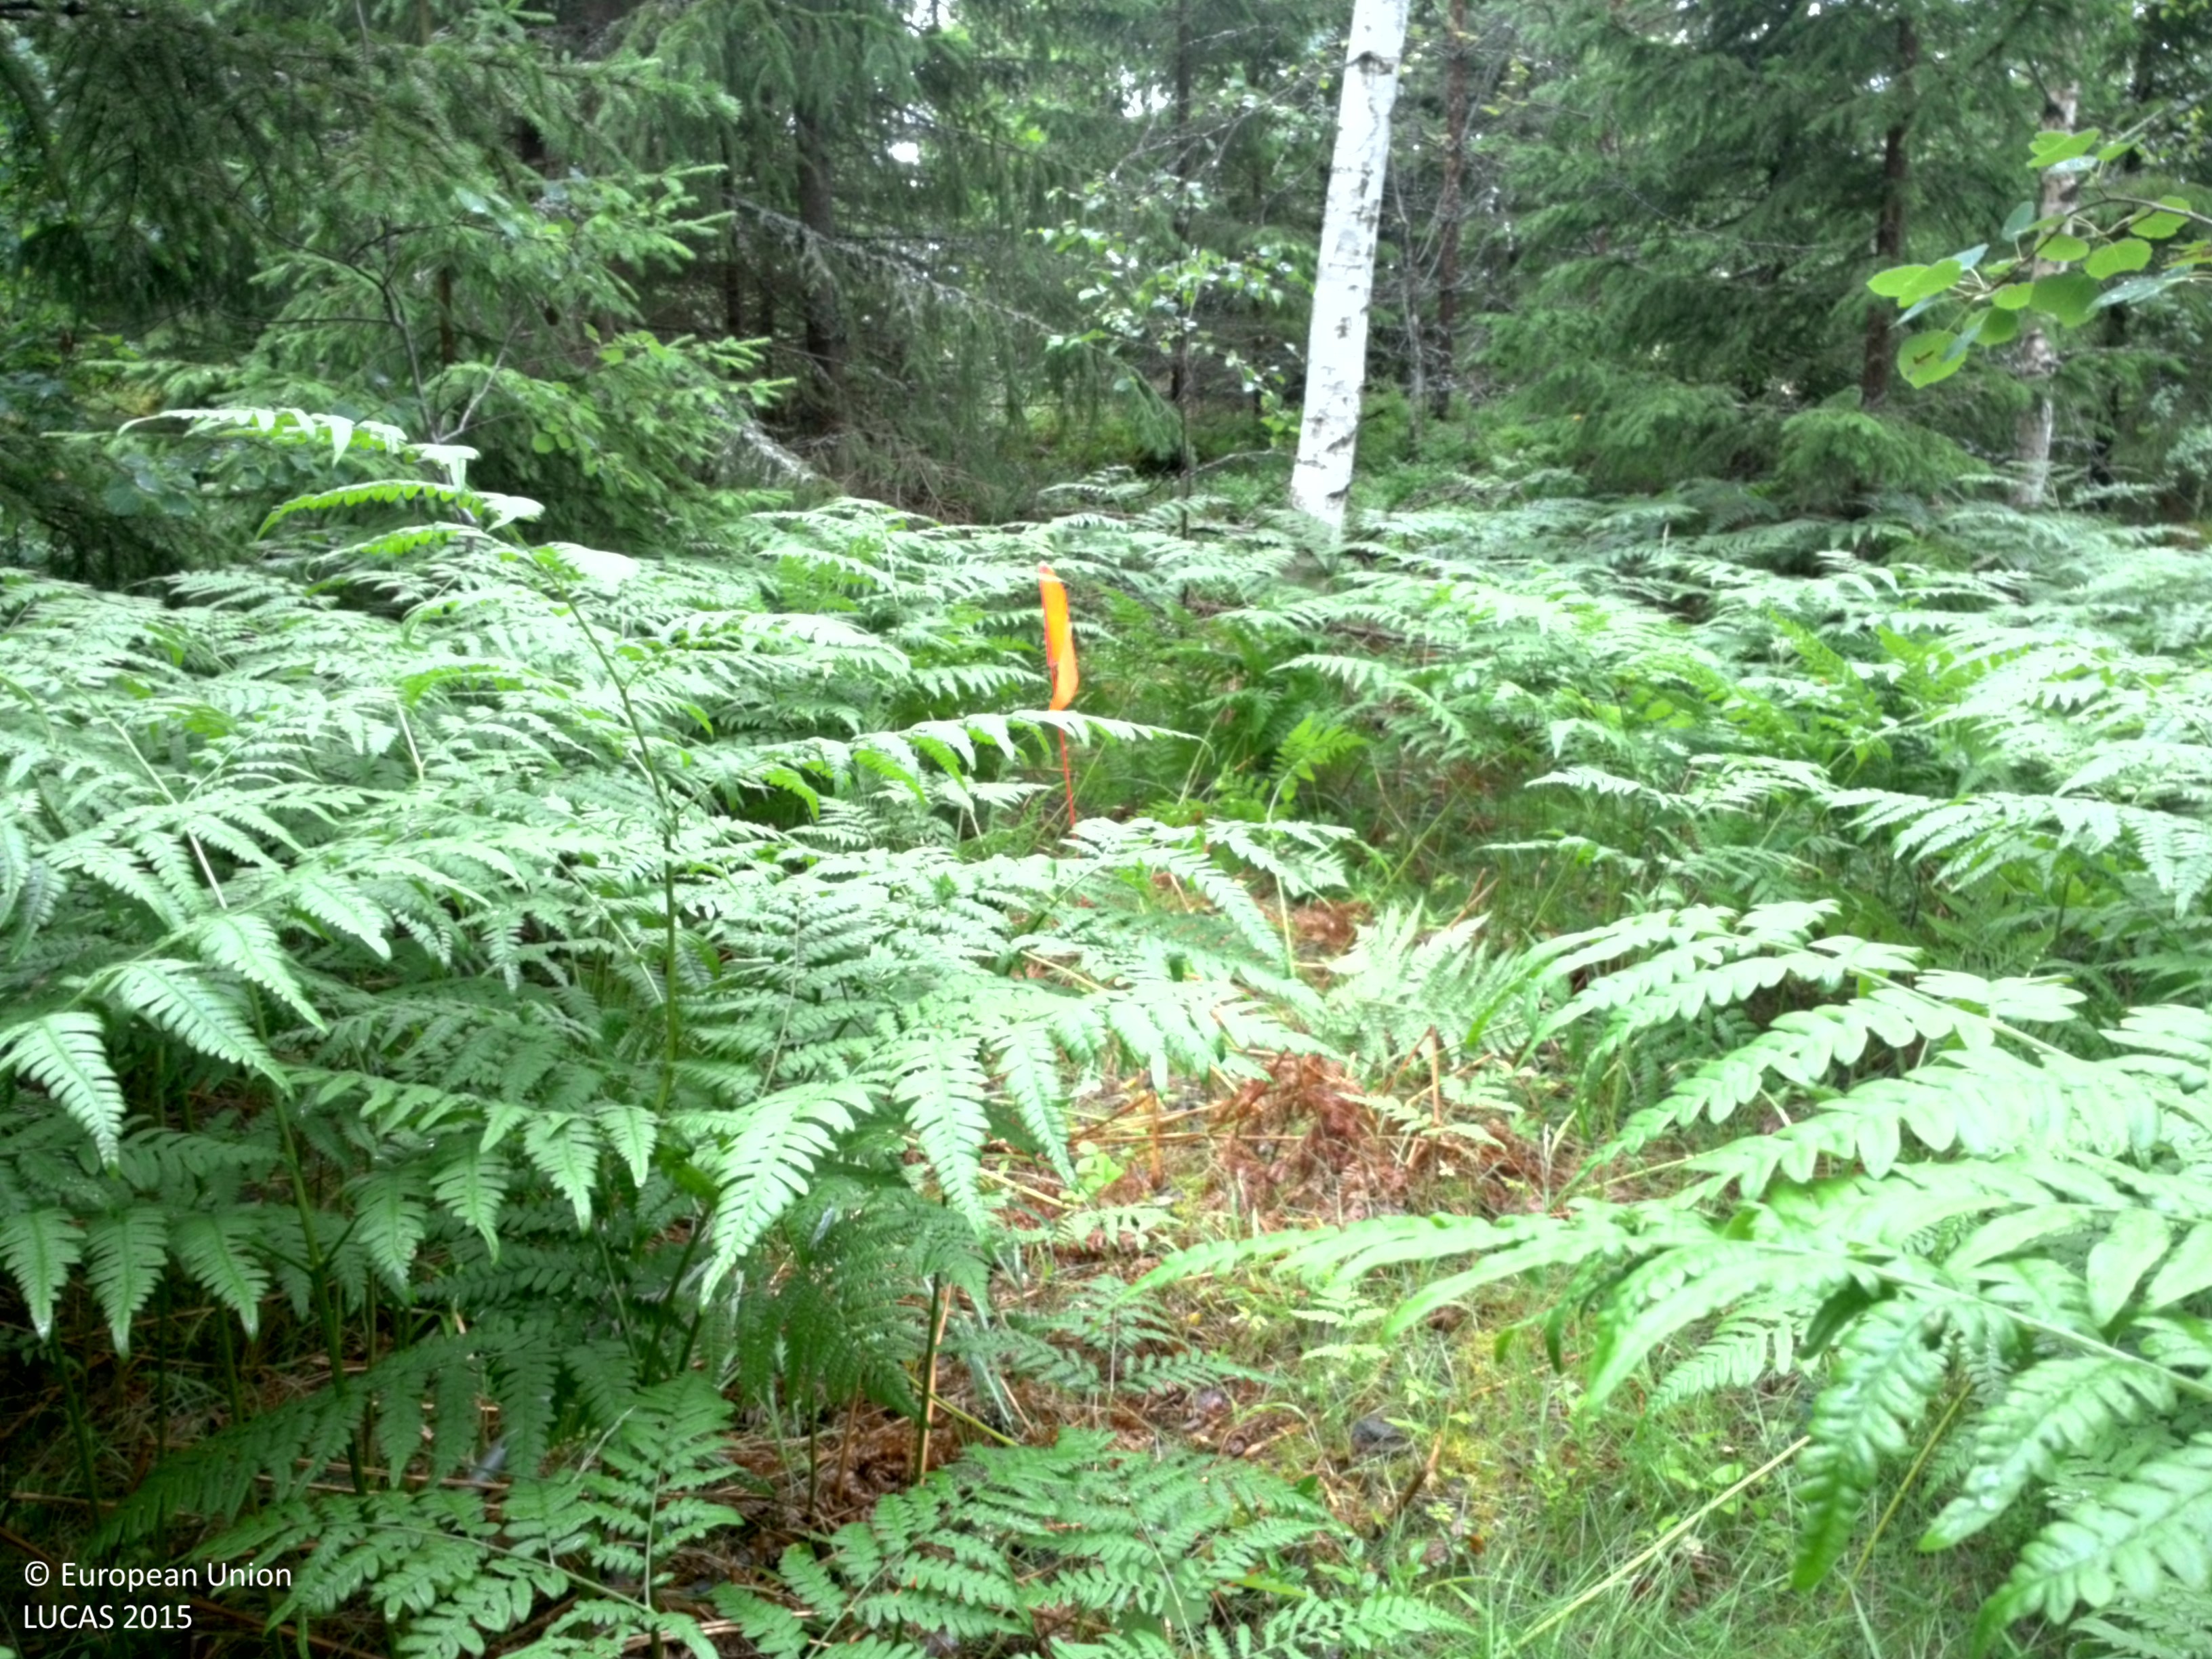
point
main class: Woodland
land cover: Other coniferous woodland
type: boreal forest
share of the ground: > 75 %
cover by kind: coniferous forest trees 60 %, broadleaved forest trees 20 %, herbaceous plants 20 %
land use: Forestry
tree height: > 5 m
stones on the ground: < 10 %
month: July
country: SE
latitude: 60.1587
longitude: 17.2162
